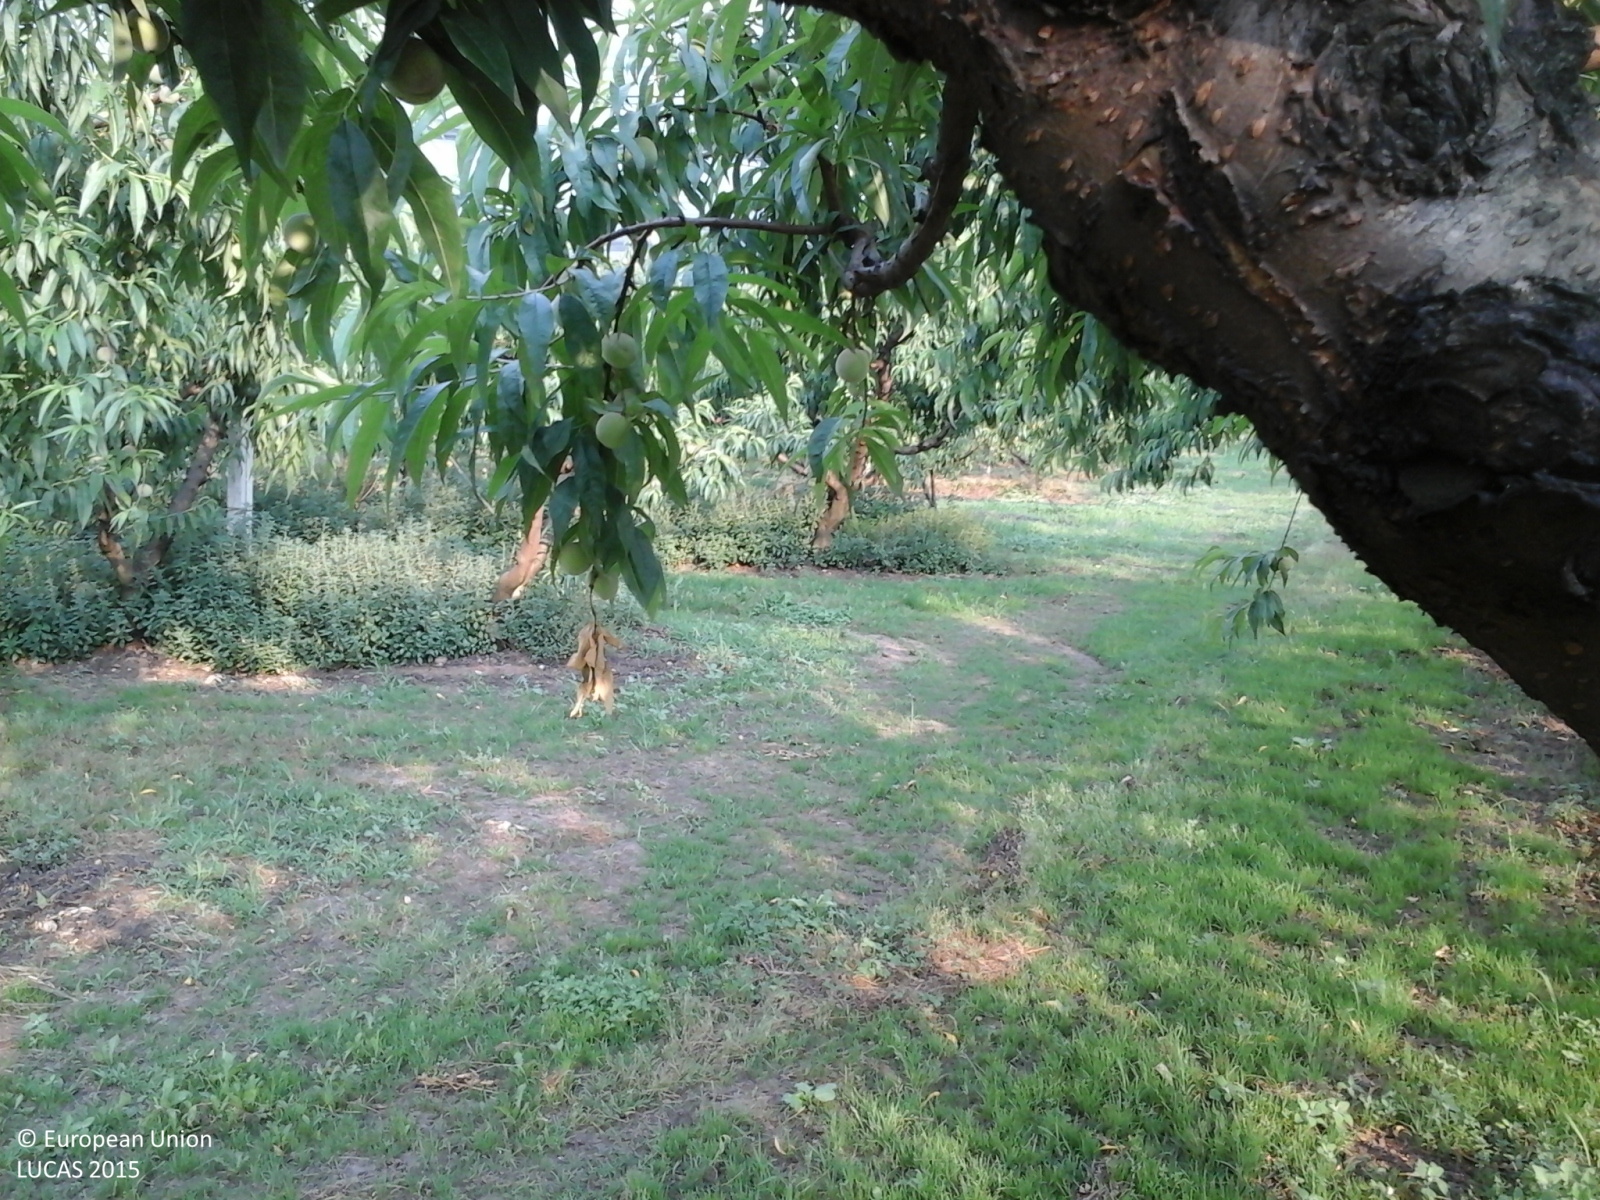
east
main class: Cropland
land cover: Other fruit trees and berries
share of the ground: 50 - 75 %
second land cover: Grassland without tree/shrub cover
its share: > 75 %
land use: Agriculture (excluding fallow land and kitchen gardens)
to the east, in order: Other fruit trees and berries; Grassland without tree/shrub cover; Other fruit trees and berries; Ditches and canals; Vineyards
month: June
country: IT
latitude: 45.5011
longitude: 10.8305
